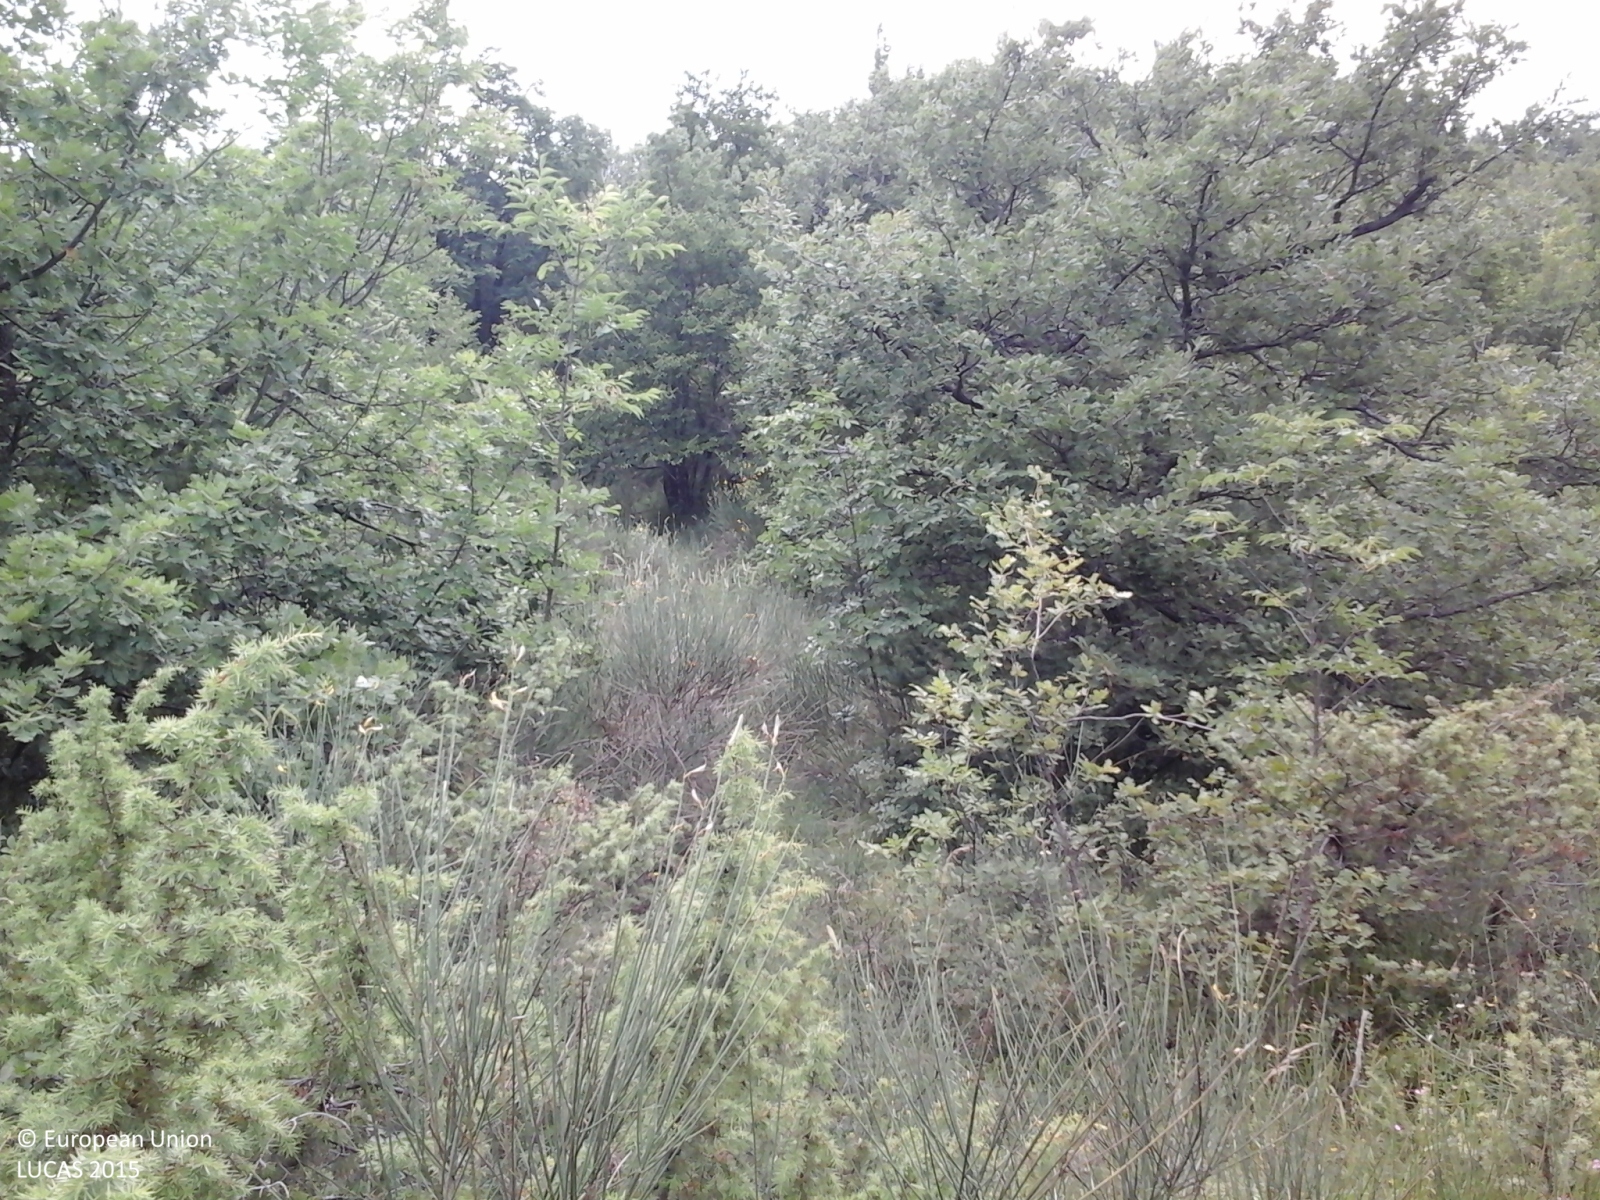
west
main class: Woodland
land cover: Broadleaved woodland
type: thermophilous deciduous forest
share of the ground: > 75 %
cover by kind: broadleaved forest trees 95 %, shrubs 5 %
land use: Semi-natural and natural areas not in use
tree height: > 5 m
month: June
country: IT
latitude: 44.1753
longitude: 11.6347
